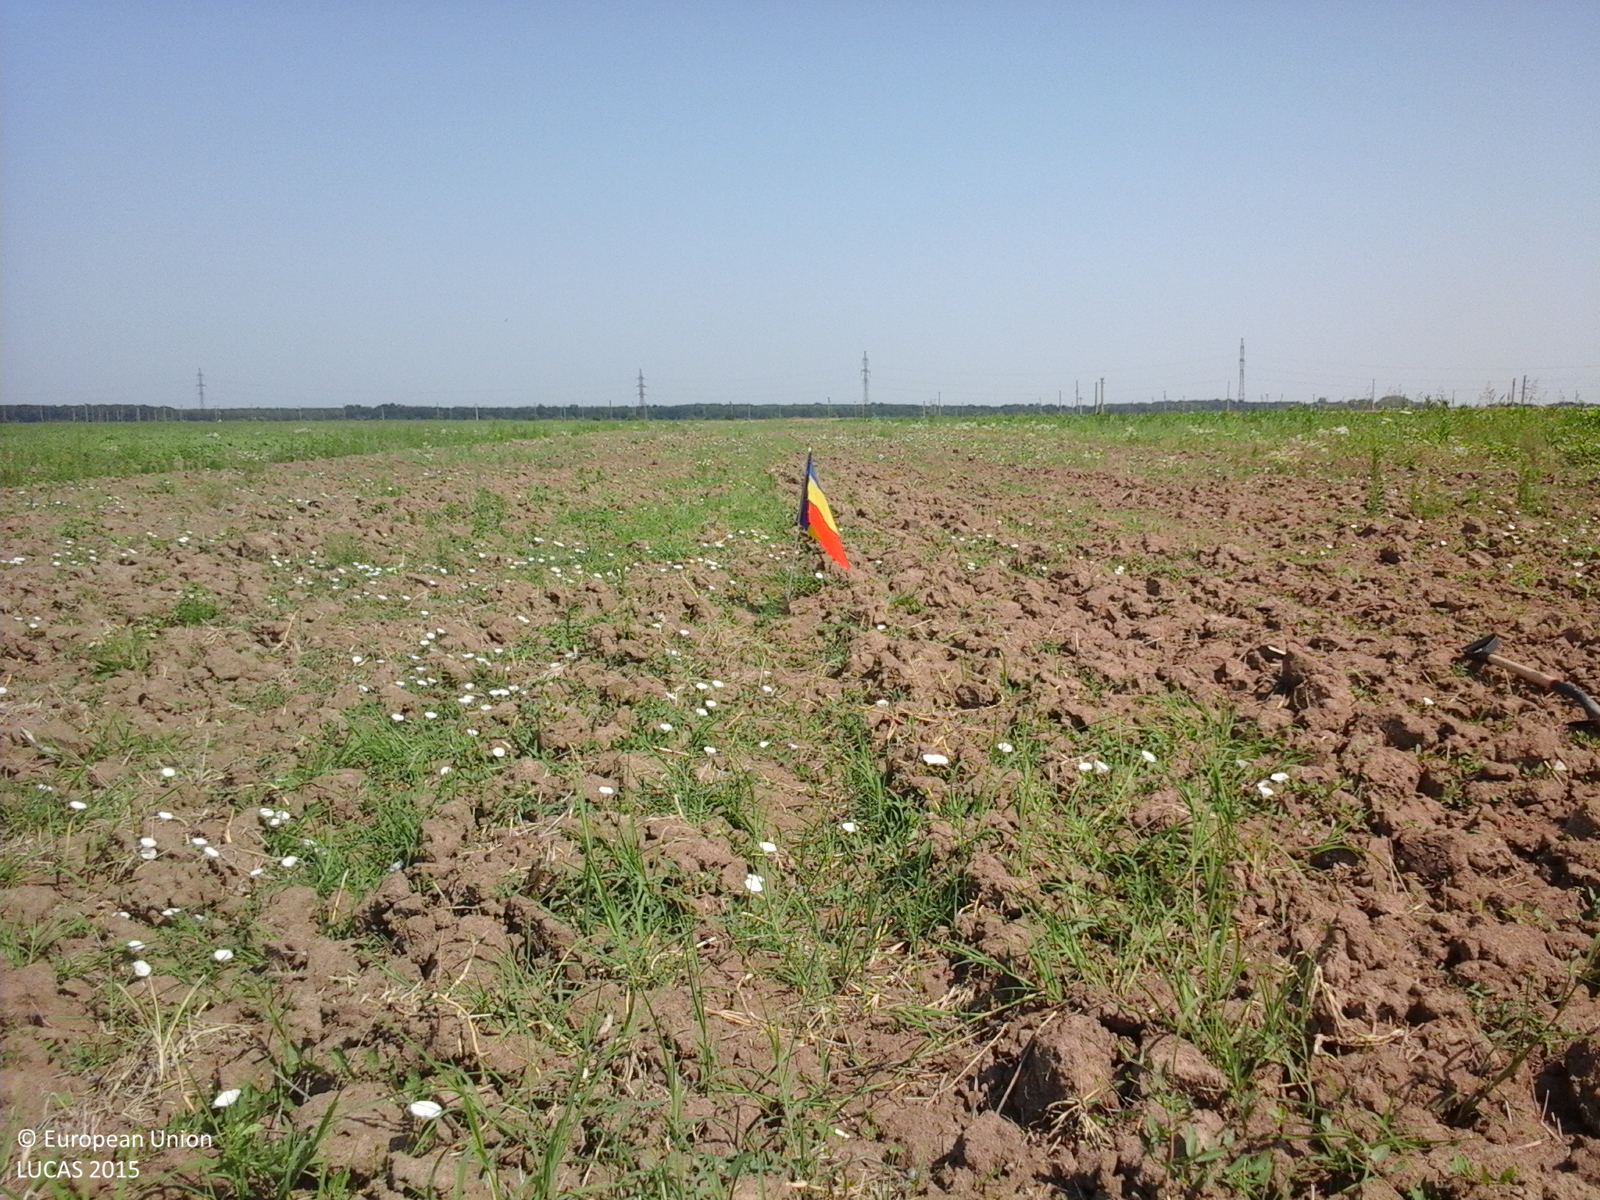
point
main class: Cropland
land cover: Durum wheat
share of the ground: < 10 %
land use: Agriculture (excluding fallow land and kitchen gardens)
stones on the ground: < 10 %
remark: Harvested field
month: July
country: RO
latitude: 44.4183
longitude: 25.2960
